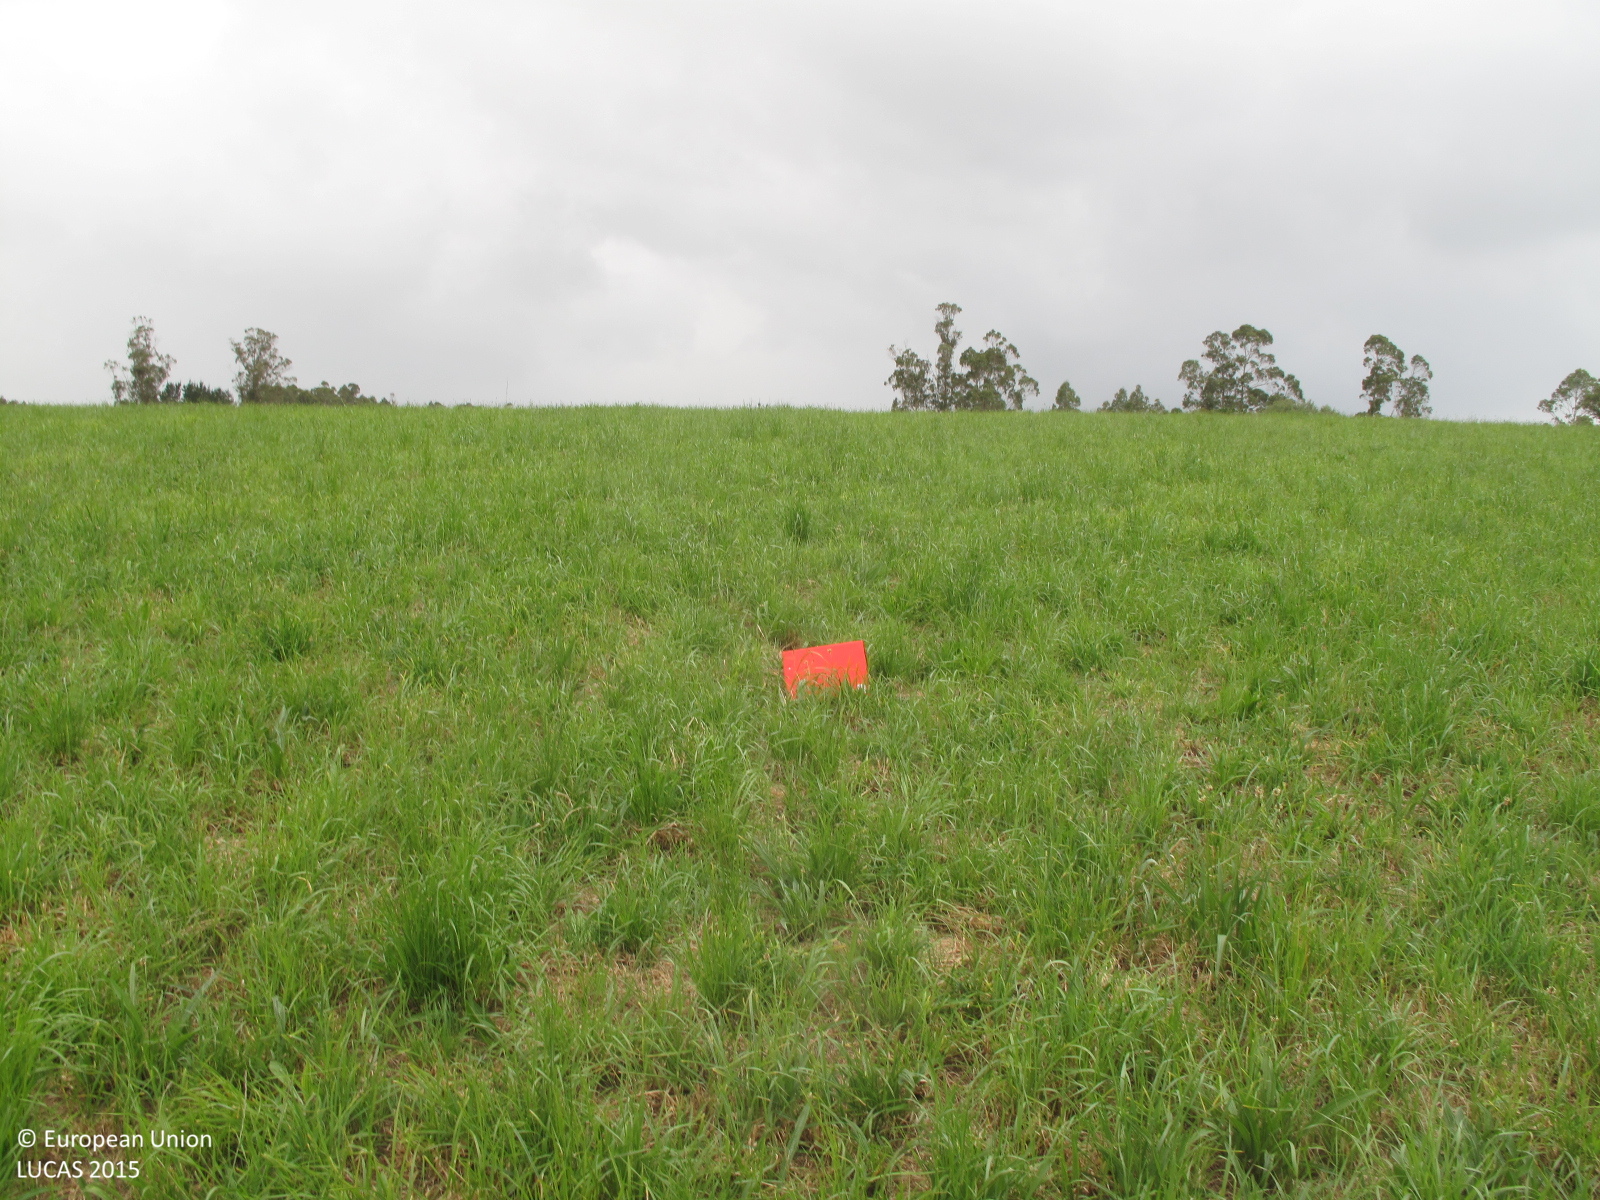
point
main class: Grassland
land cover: Grassland without tree/shrub cover
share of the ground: > 75 %
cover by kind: herbaceous plants 100 %
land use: Agriculture (excluding fallow land and kitchen gardens)
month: June
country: ES
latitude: 43.1508
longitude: -8.5921
